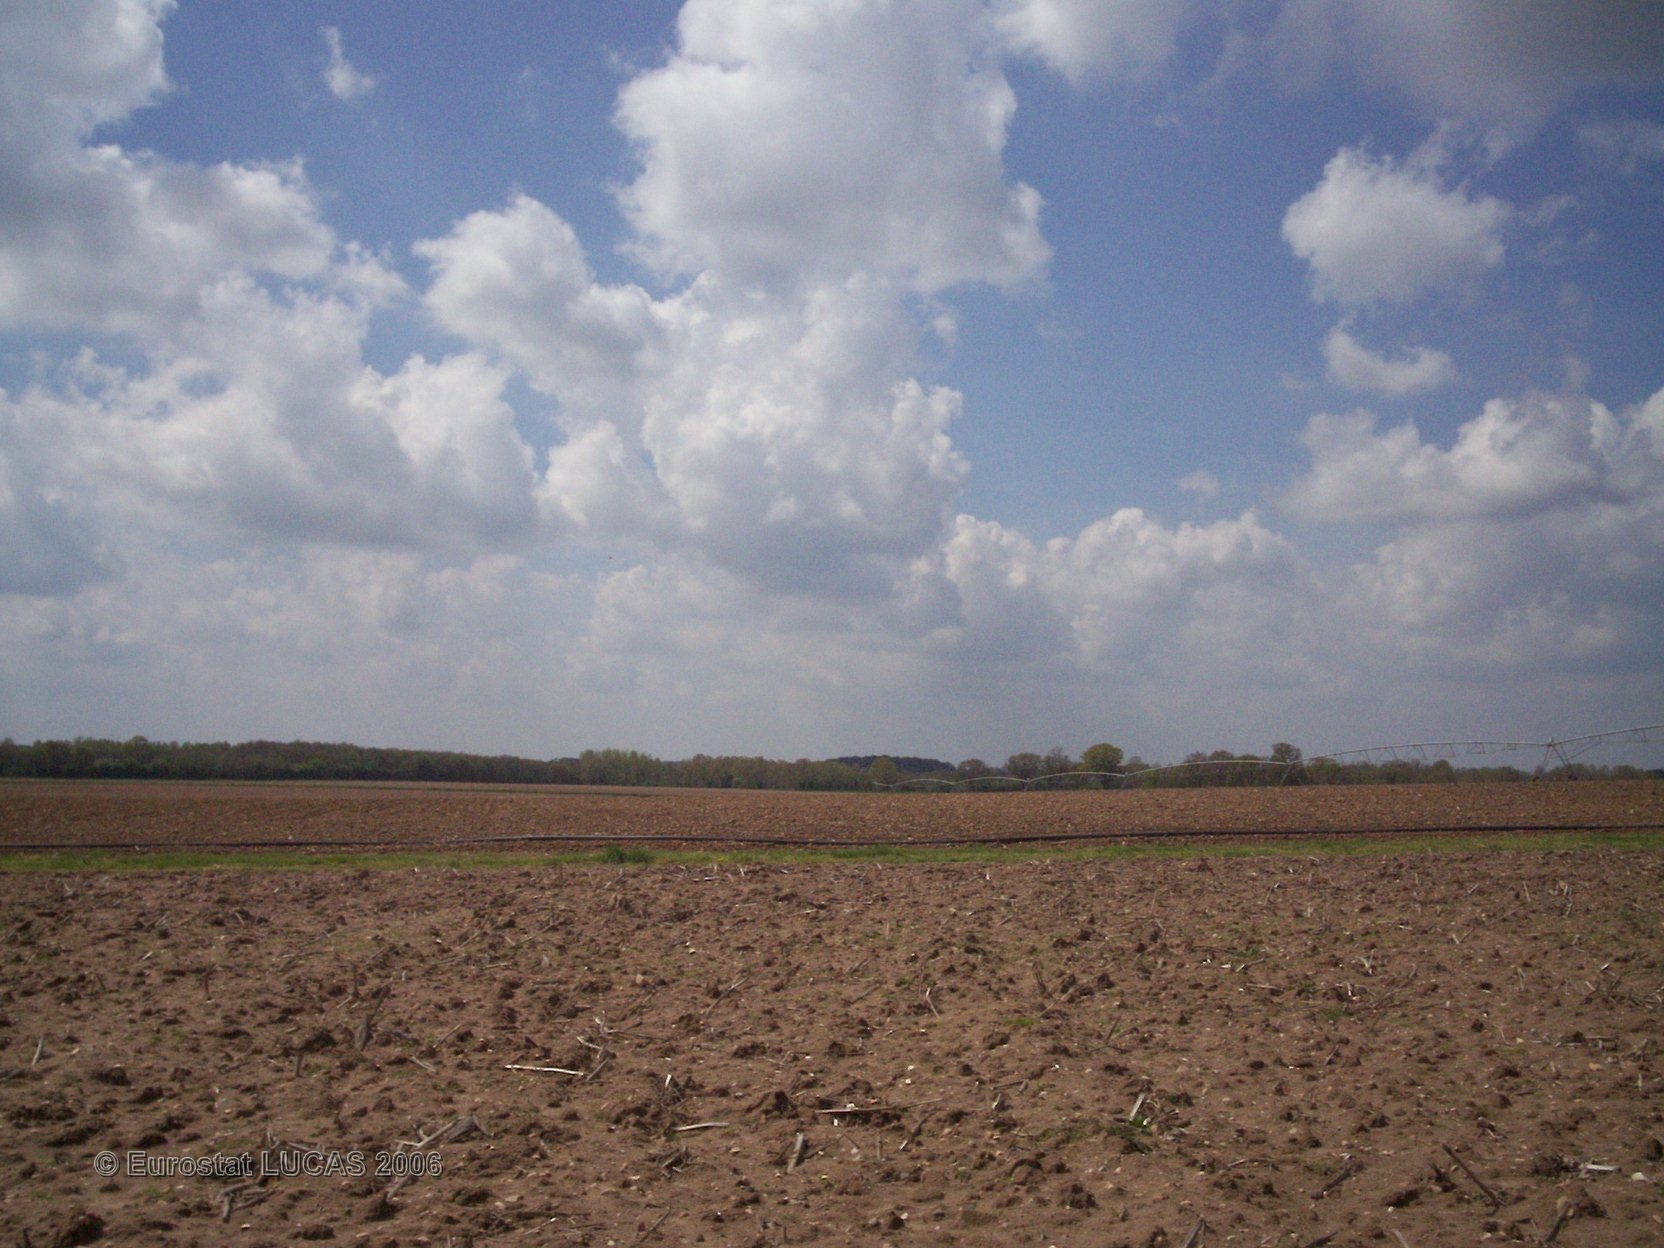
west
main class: Cropland
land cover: Maize
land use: Agriculture (excluding fallow land and kitchen gardens)
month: June
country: FR
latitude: 46.3098
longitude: 0.5174
